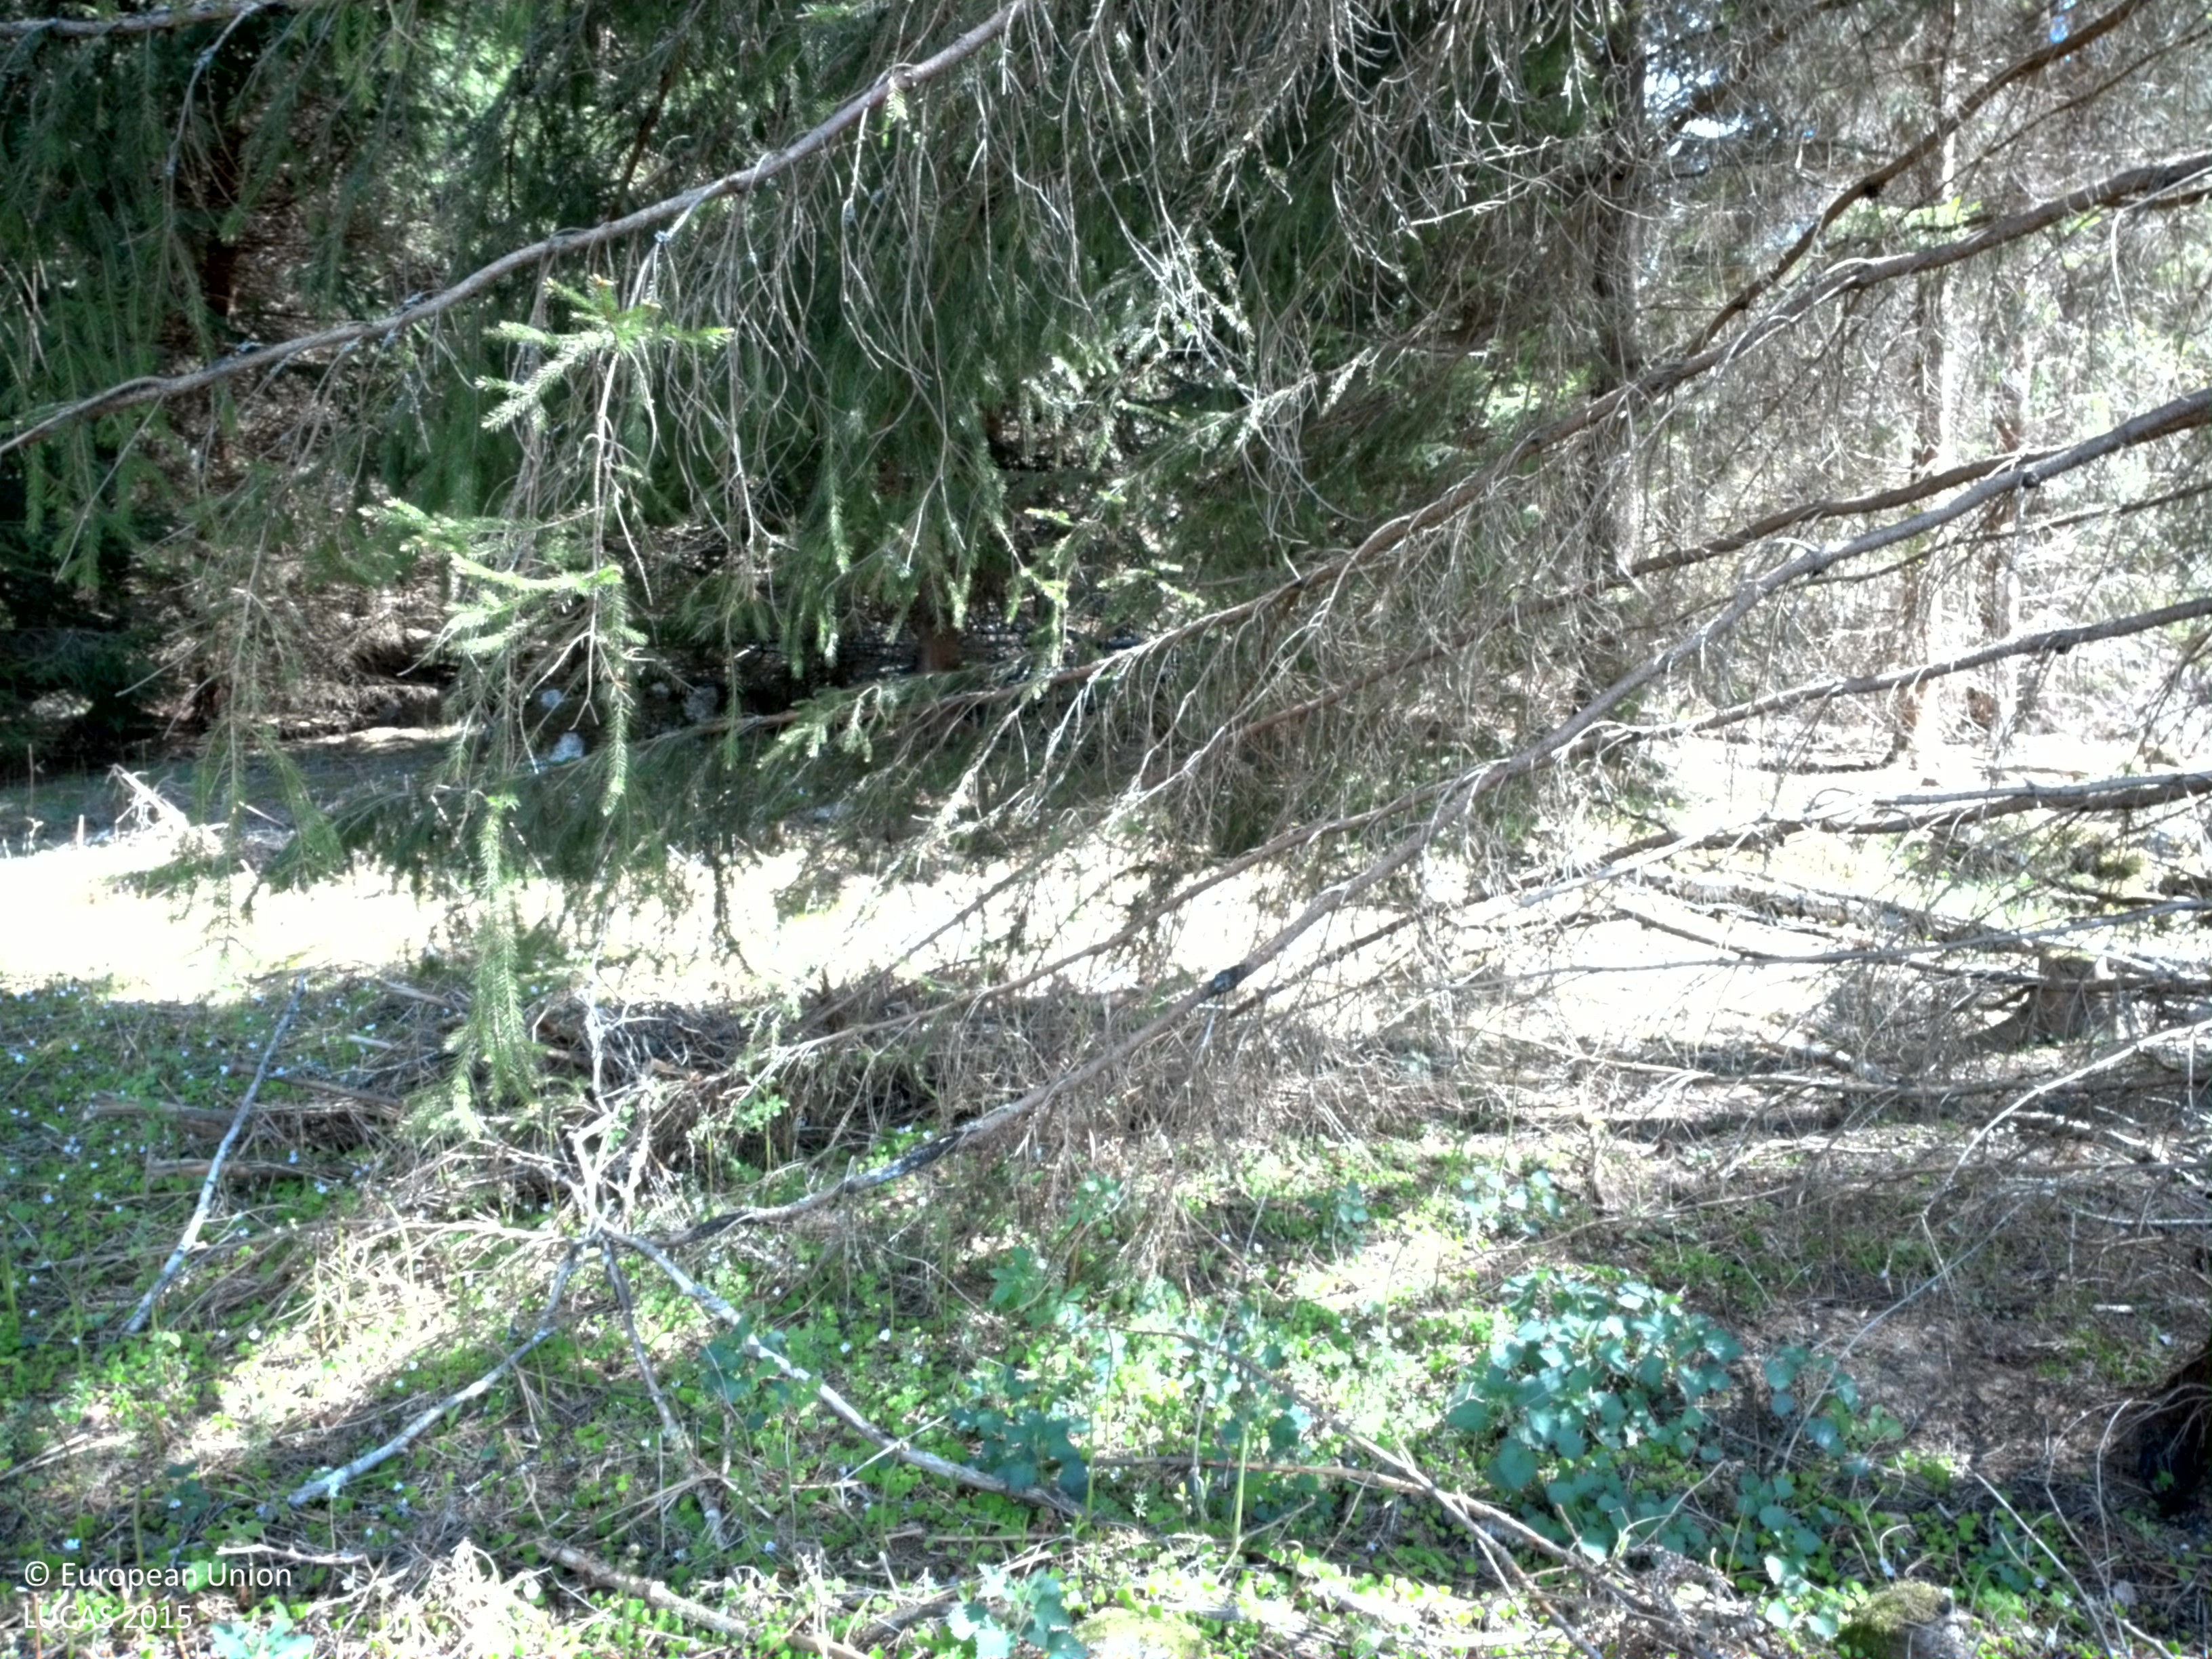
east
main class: Woodland
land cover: Spruce dominated mixed woodland
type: boreal forest
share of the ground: > 75 %
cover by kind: coniferous forest trees 75 %, broadleaved forest trees 25 %
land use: Forestry
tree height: > 5 m
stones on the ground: < 10 %
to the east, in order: Spruce dominated mixed woodland; Spruce dominated coniferous woodland; Tracks; Spruce dominated mixed woodland; Other bare soil; Broadleaved woodland; Spruce dominated coniferous woodland
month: May
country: SE
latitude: 56.4373
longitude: 15.3347
